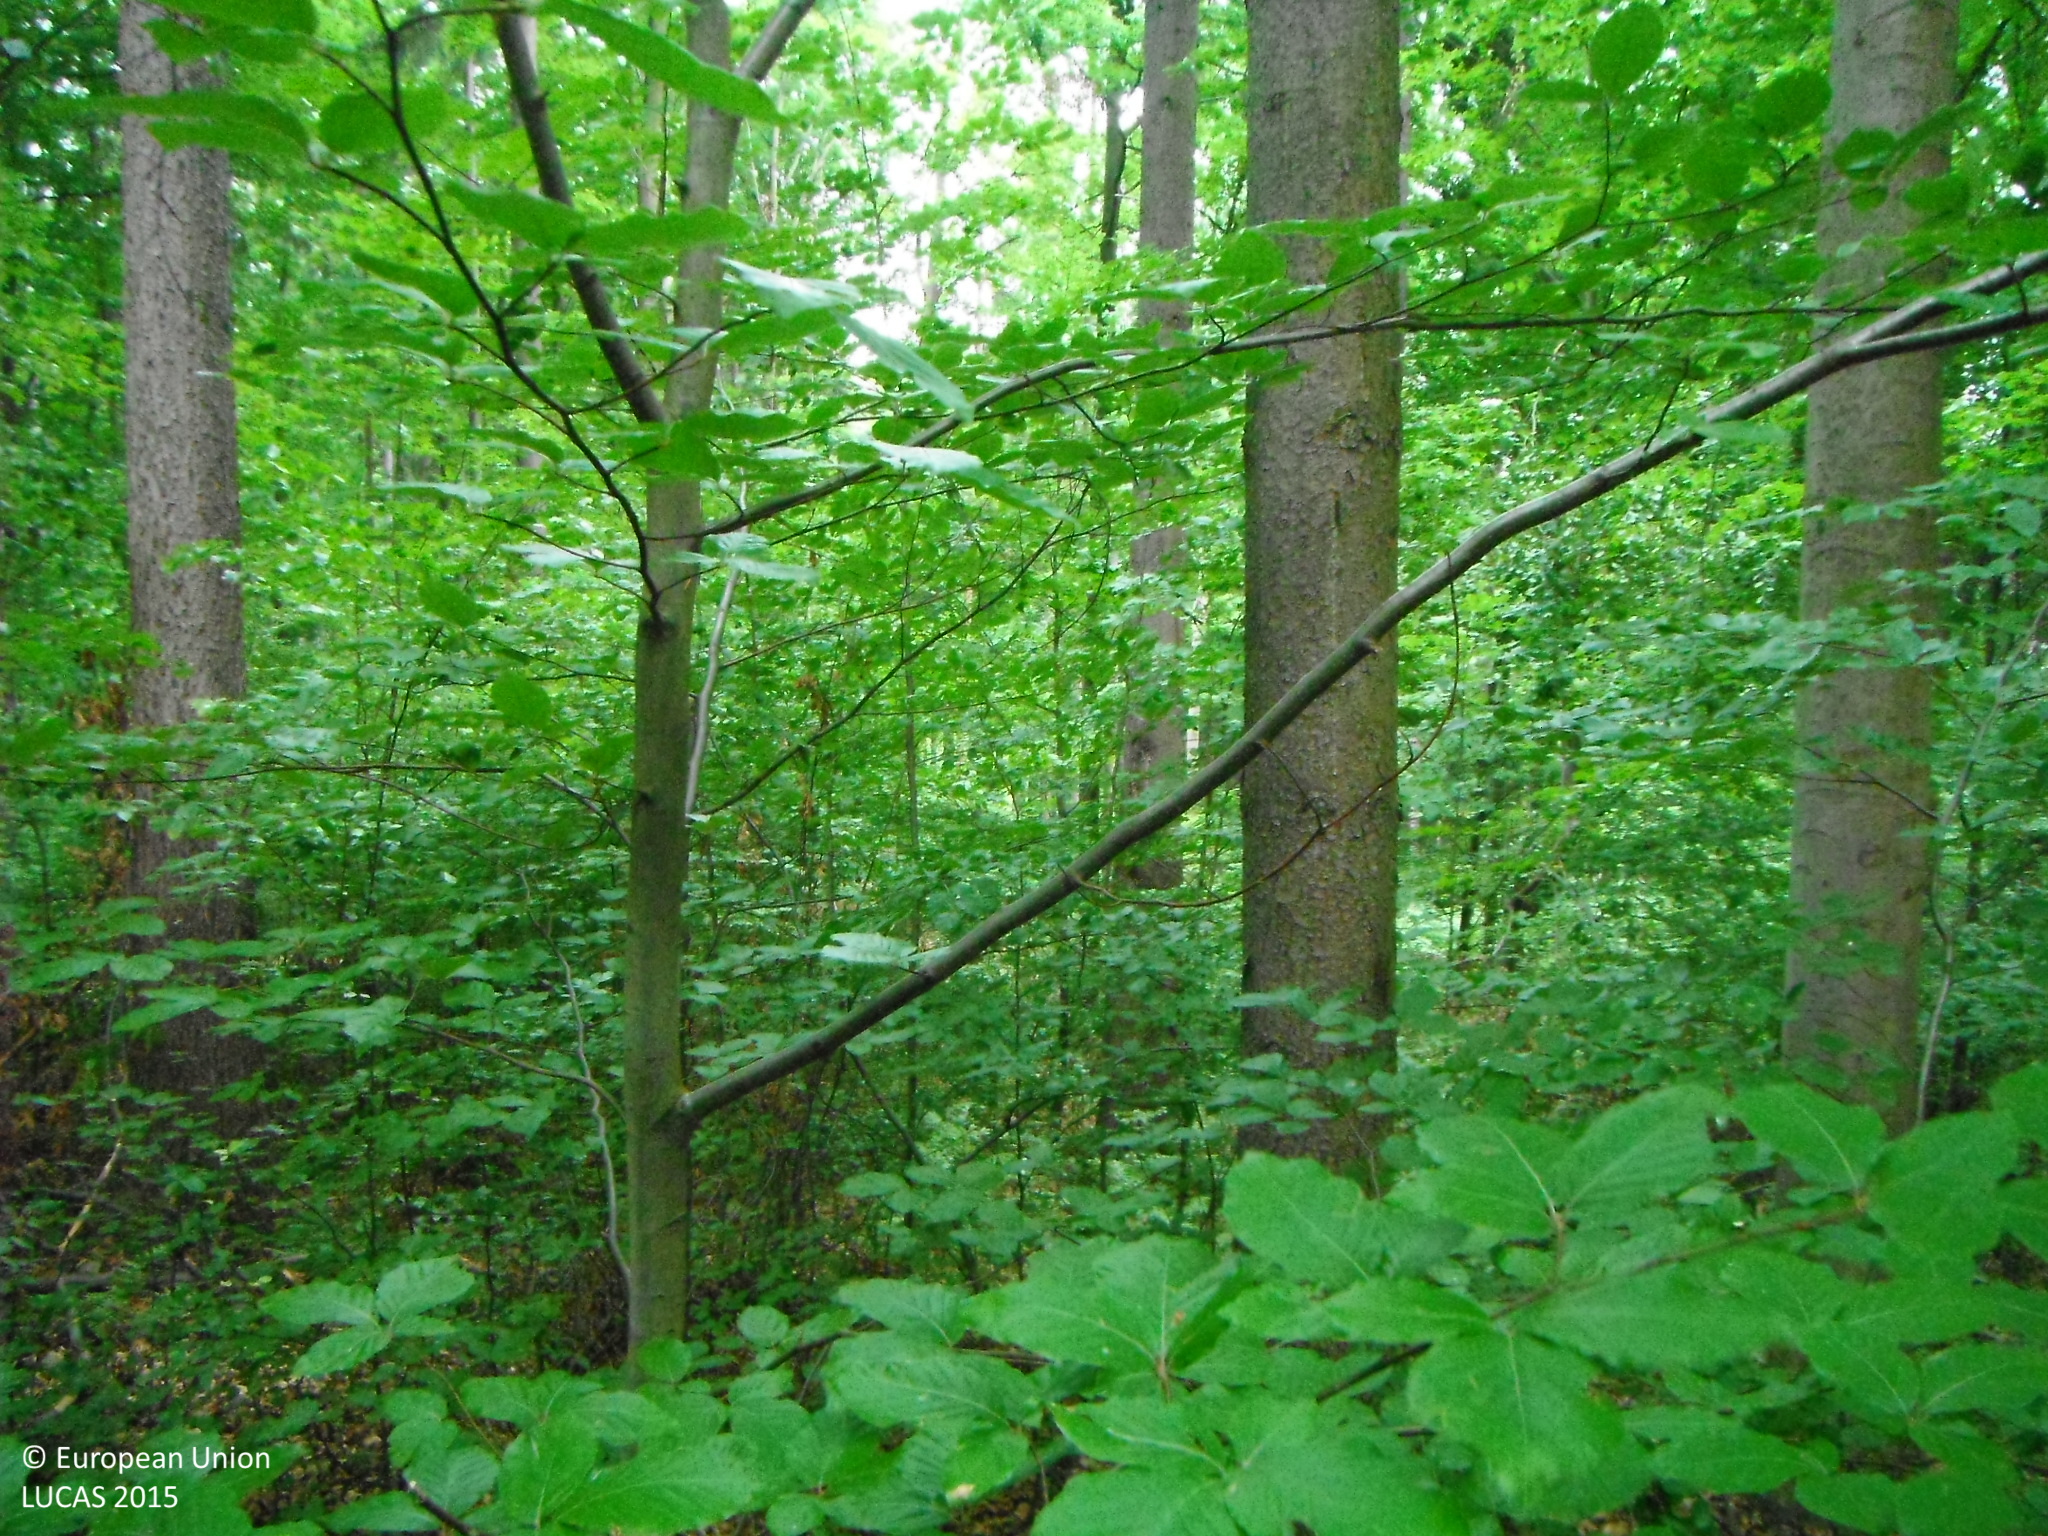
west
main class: Woodland
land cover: Spruce dominated mixed woodland
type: alpine coniferous forest
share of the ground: > 75 %
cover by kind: coniferous forest trees 60 %, broadleaved forest trees 40 %
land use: Forestry
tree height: > 5 m
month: June
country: SK
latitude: 48.5204
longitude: 19.2701
